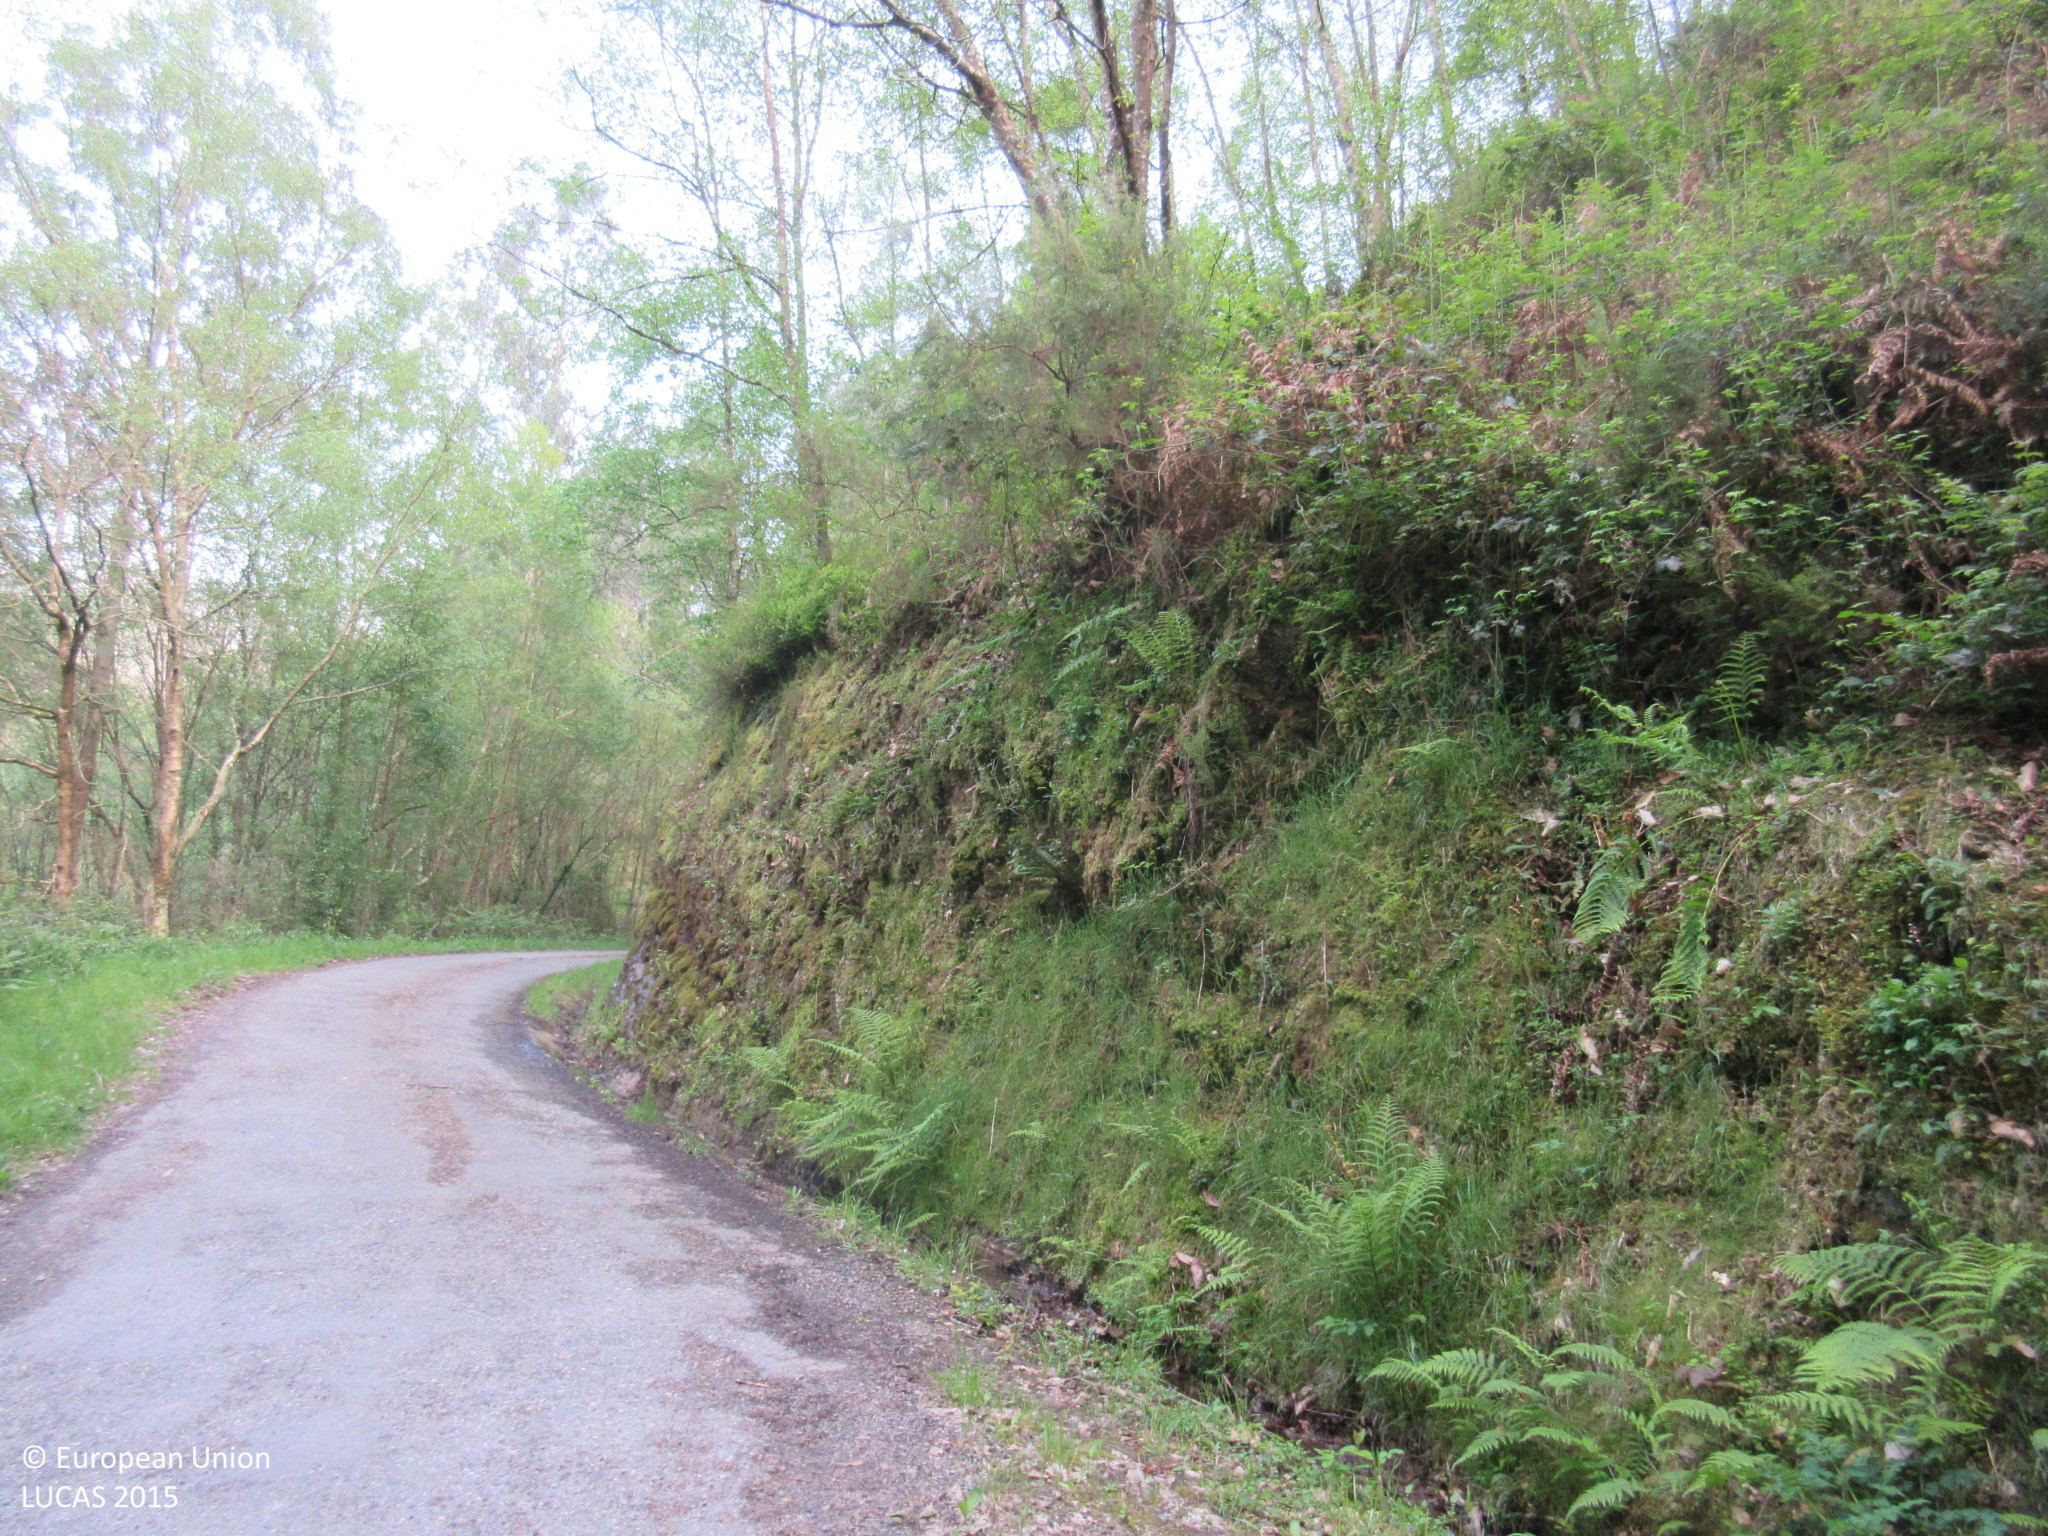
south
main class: Woodland
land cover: Broadleaved woodland
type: exotic forest
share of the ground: > 75 %
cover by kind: broadleaved forest trees 90 %, shrubs 10 %
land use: Forestry
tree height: > 5 m
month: April
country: ES
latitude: 43.4139
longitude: -6.9987
